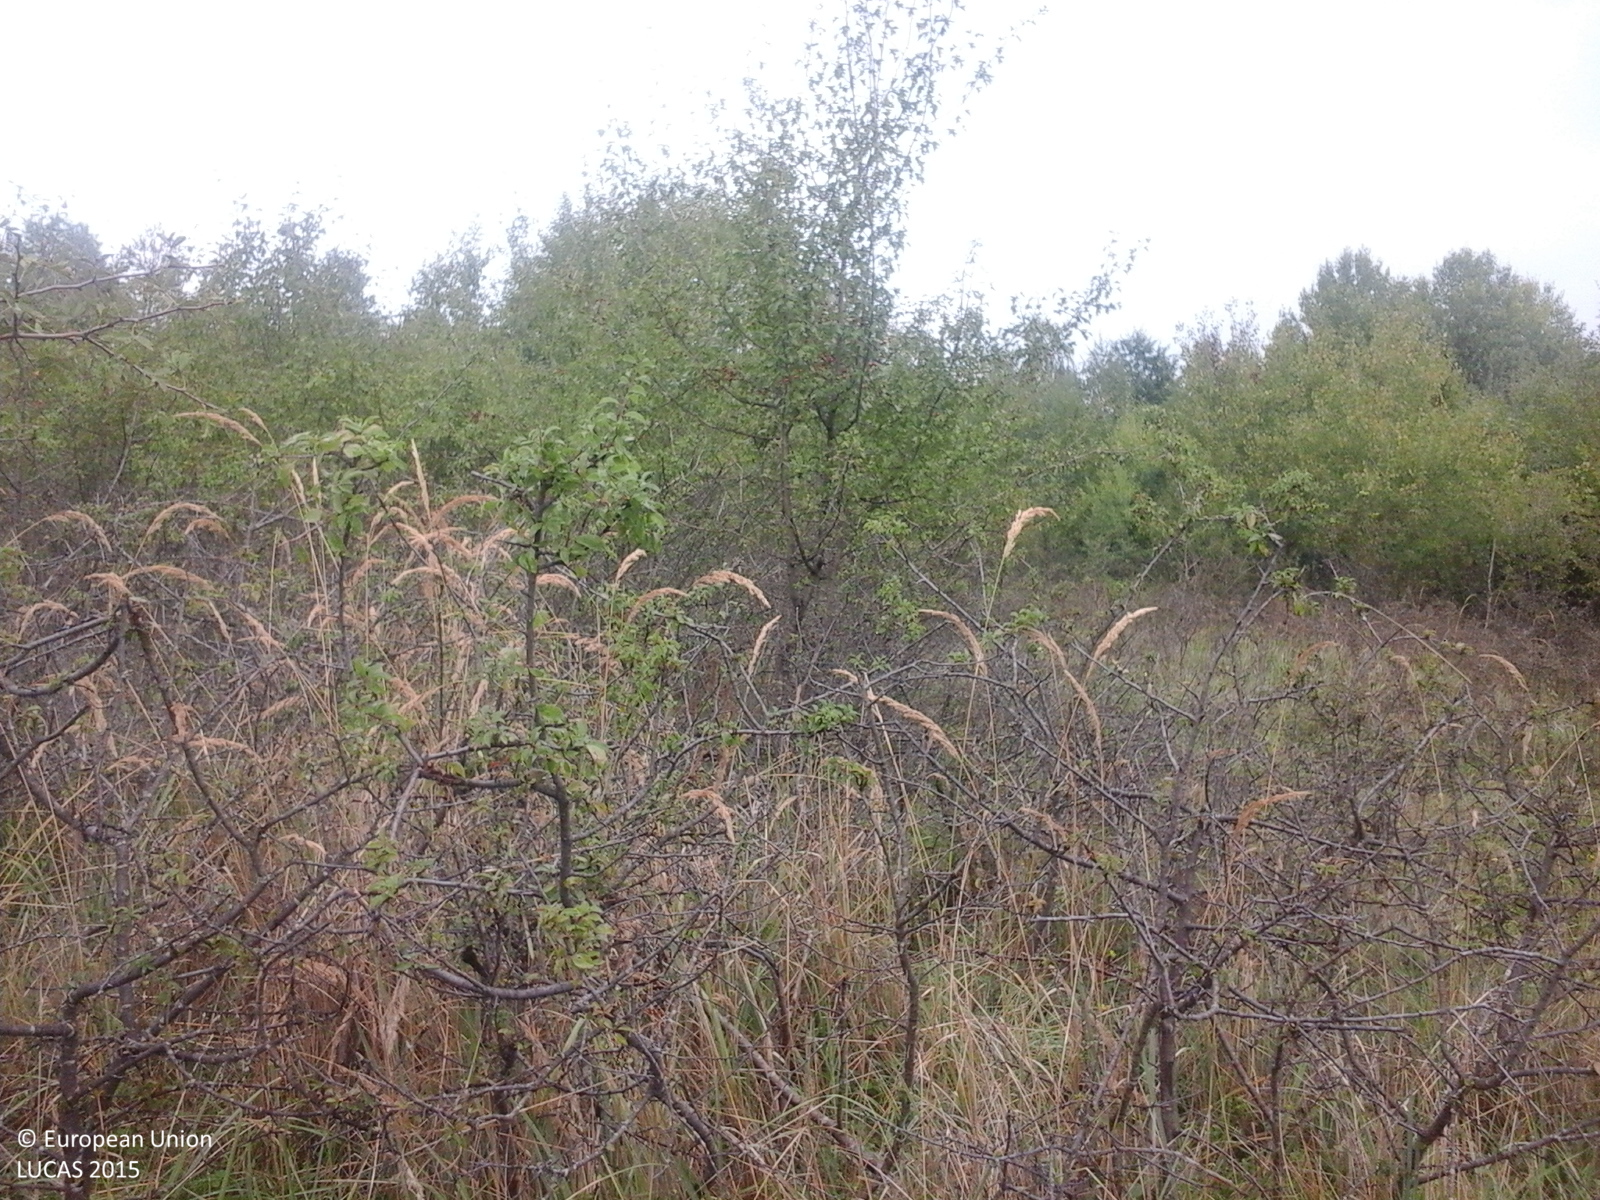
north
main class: Grassland
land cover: Grassland with sparse tree/shrub cover
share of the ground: > 75 %
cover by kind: herbaceous plants 85 %, shrubs 10 %, broadleaved forest trees 5 %
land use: Fallow land
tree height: < 5 m
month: September
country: RO
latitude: 46.9448
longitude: 22.4953
